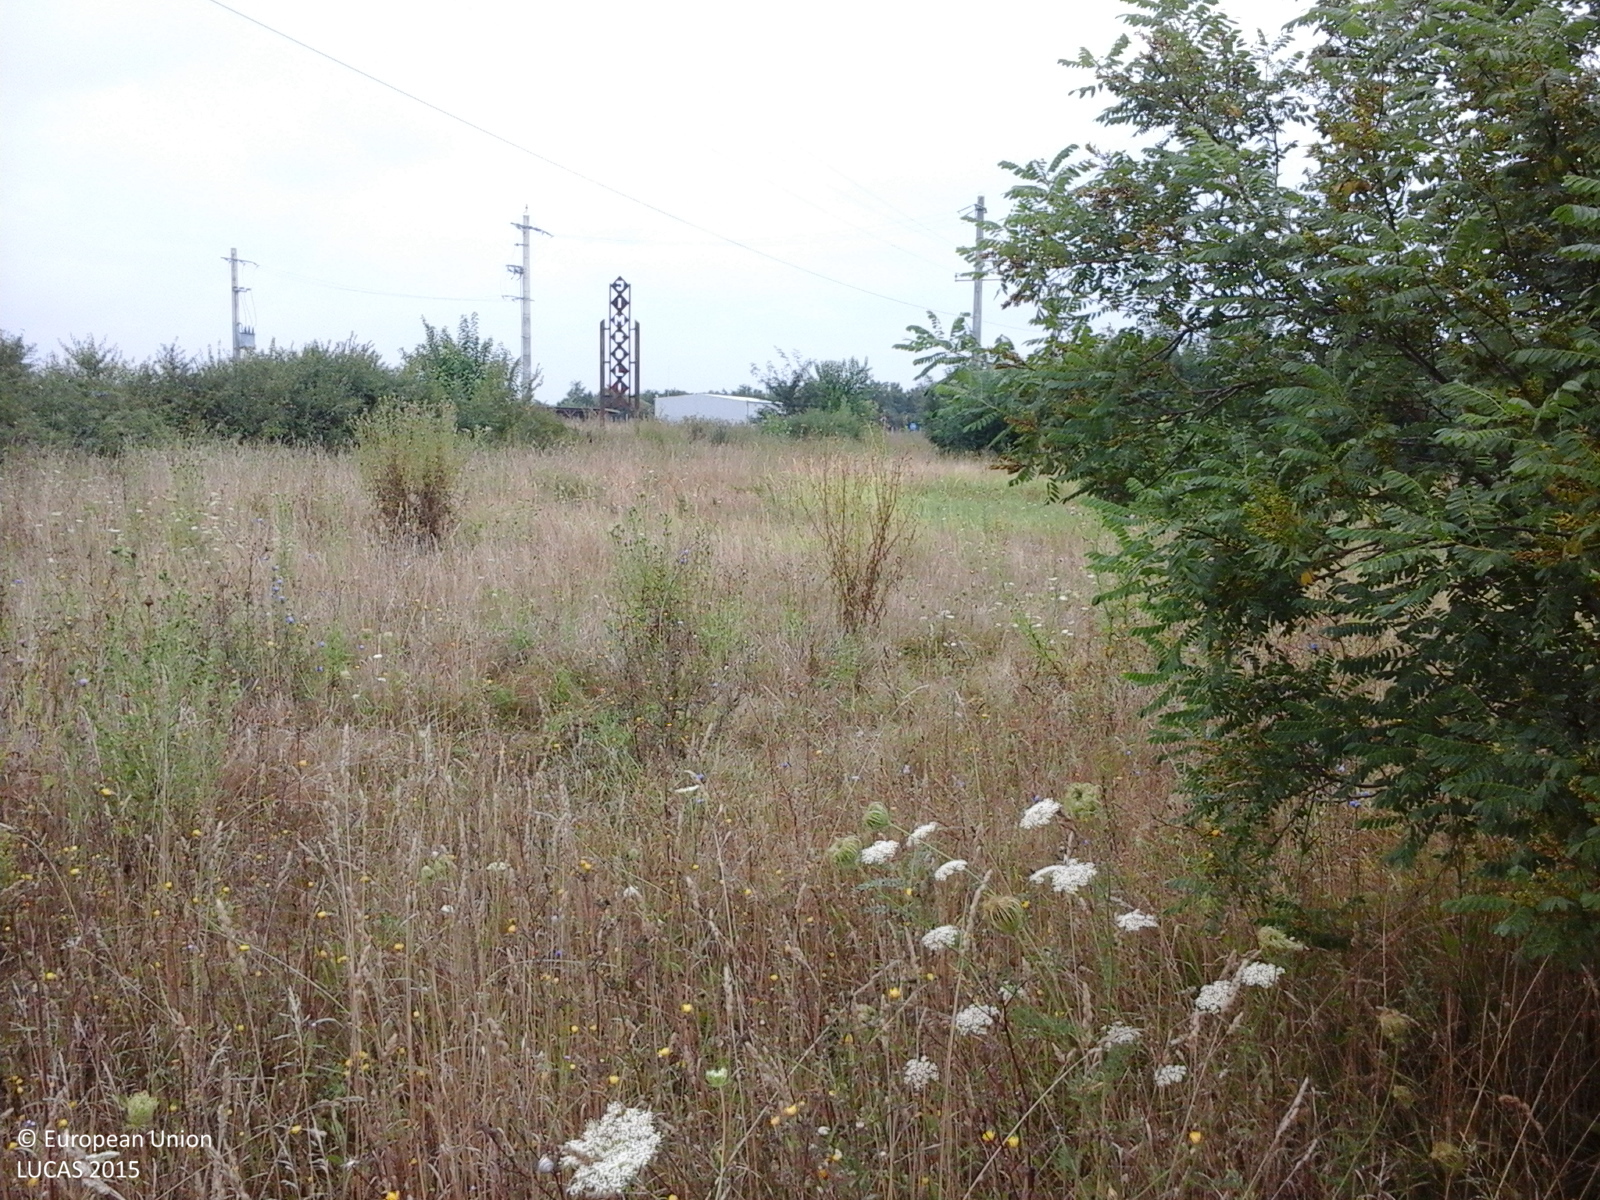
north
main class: Grassland
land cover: Grassland with sparse tree/shrub cover
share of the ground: > 75 %
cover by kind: herbaceous plants 90 %, broadleaved forest trees 5 %, shrubs 5 %
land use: Agriculture (excluding fallow land and kitchen gardens)
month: August
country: RO
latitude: 45.7753
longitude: 20.7122
